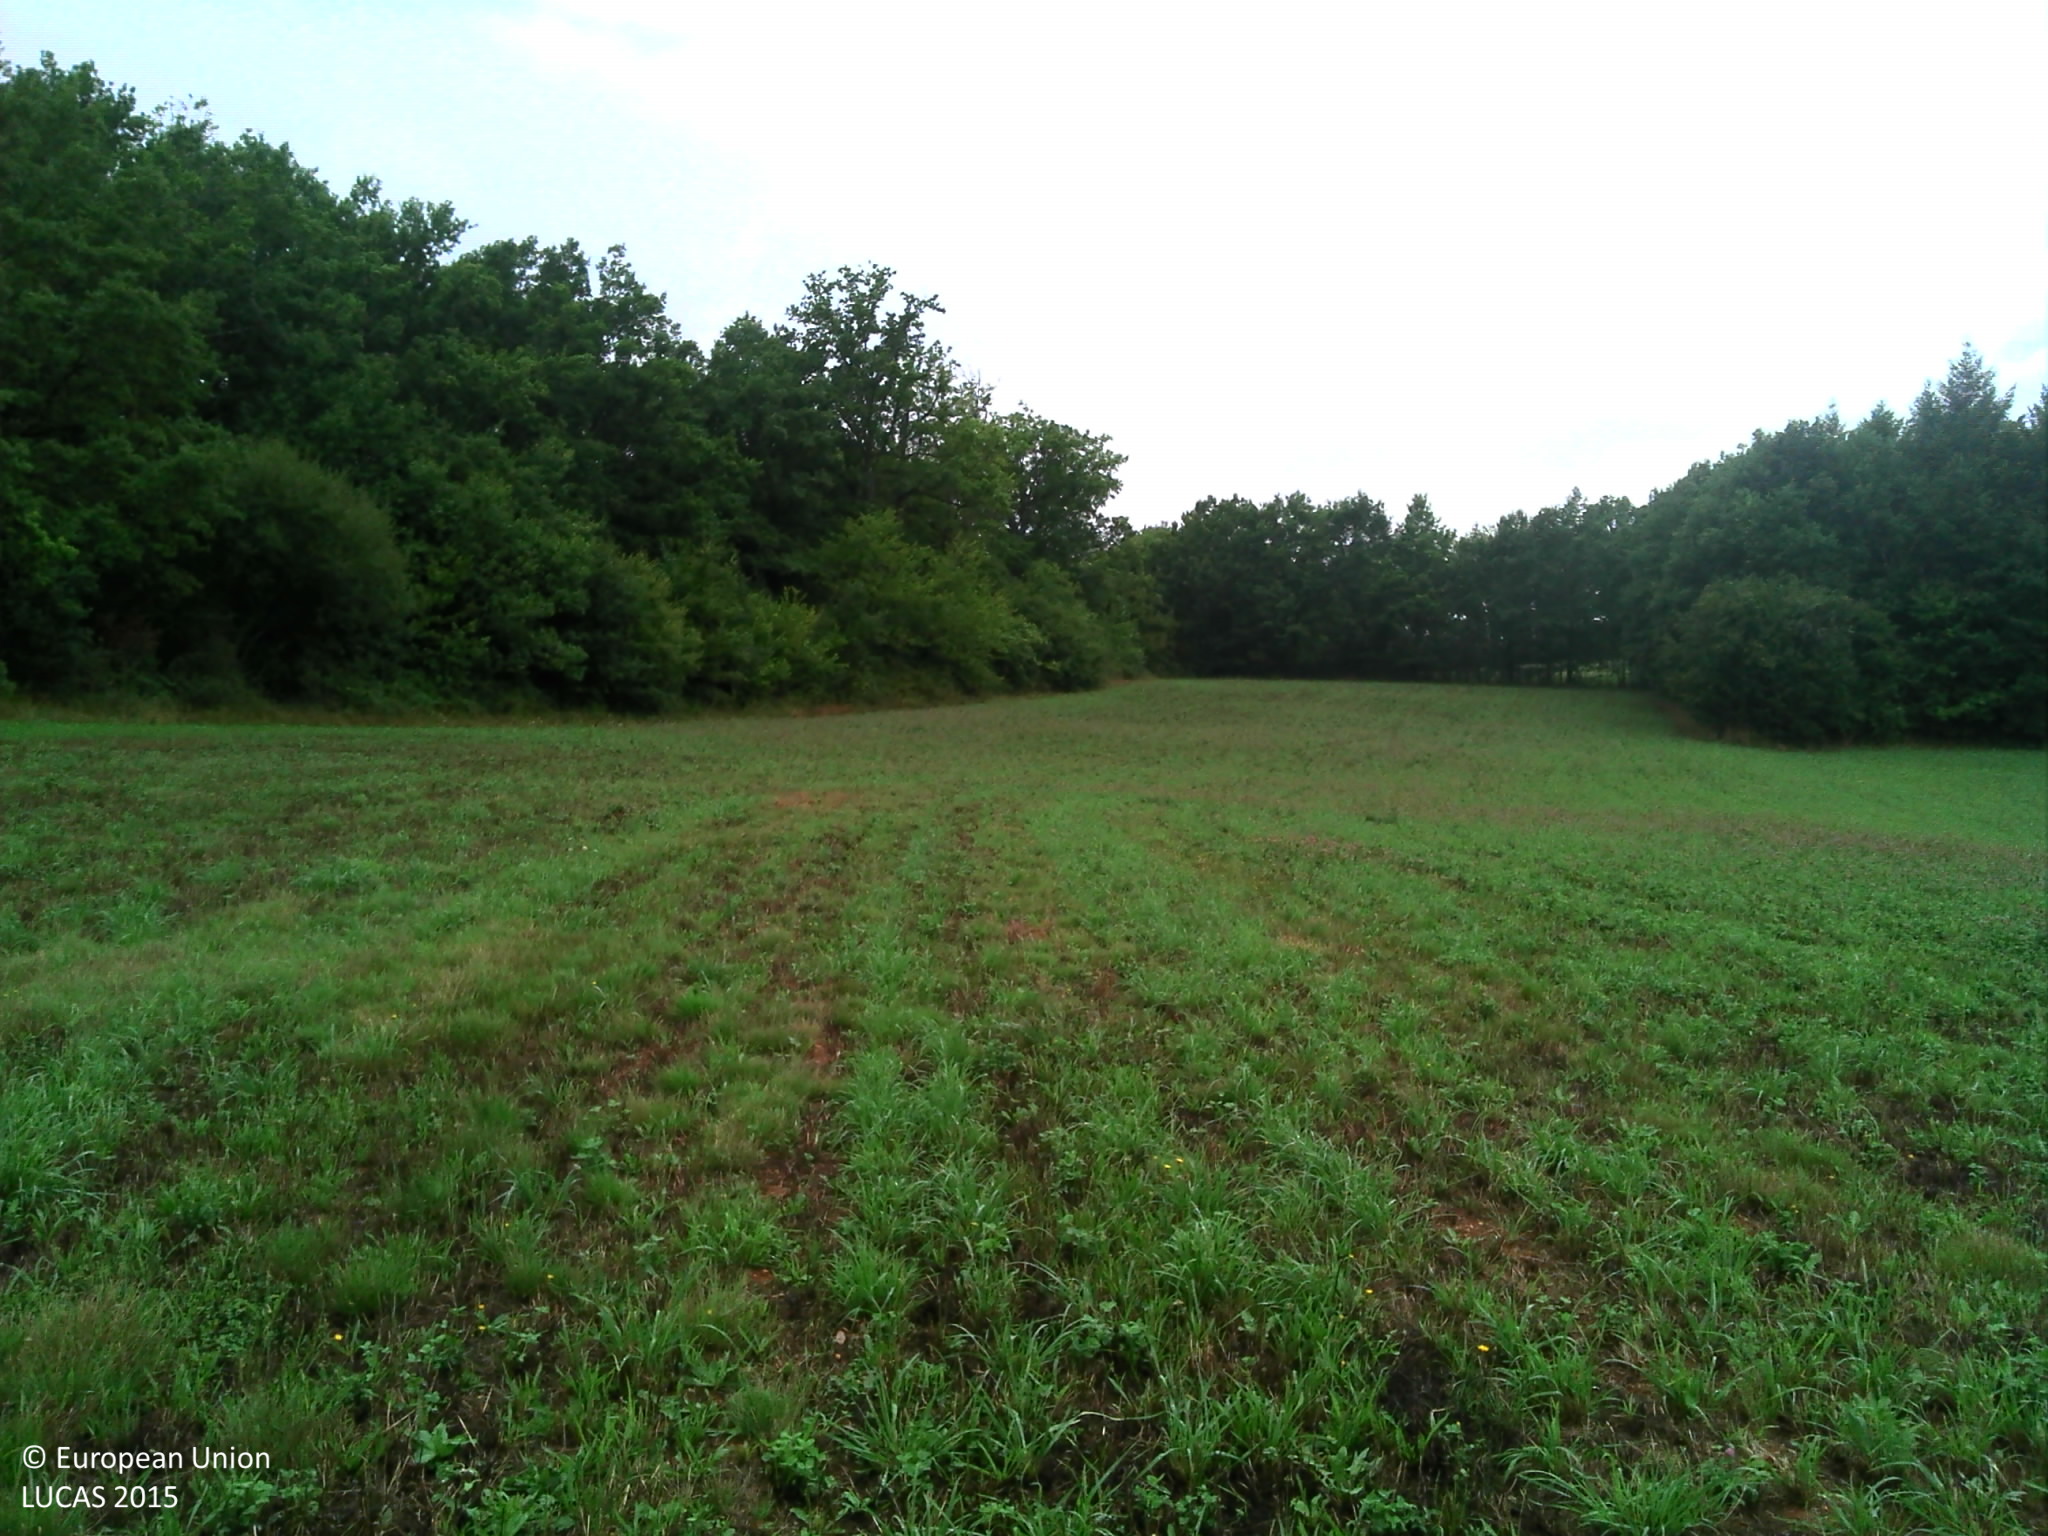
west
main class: Cropland
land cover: Temporary grasslands
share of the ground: 50 - 75 %
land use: Agriculture (excluding fallow land and kitchen gardens)
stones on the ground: < 10 %
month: August
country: FR
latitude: 45.4953
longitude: 0.7369
